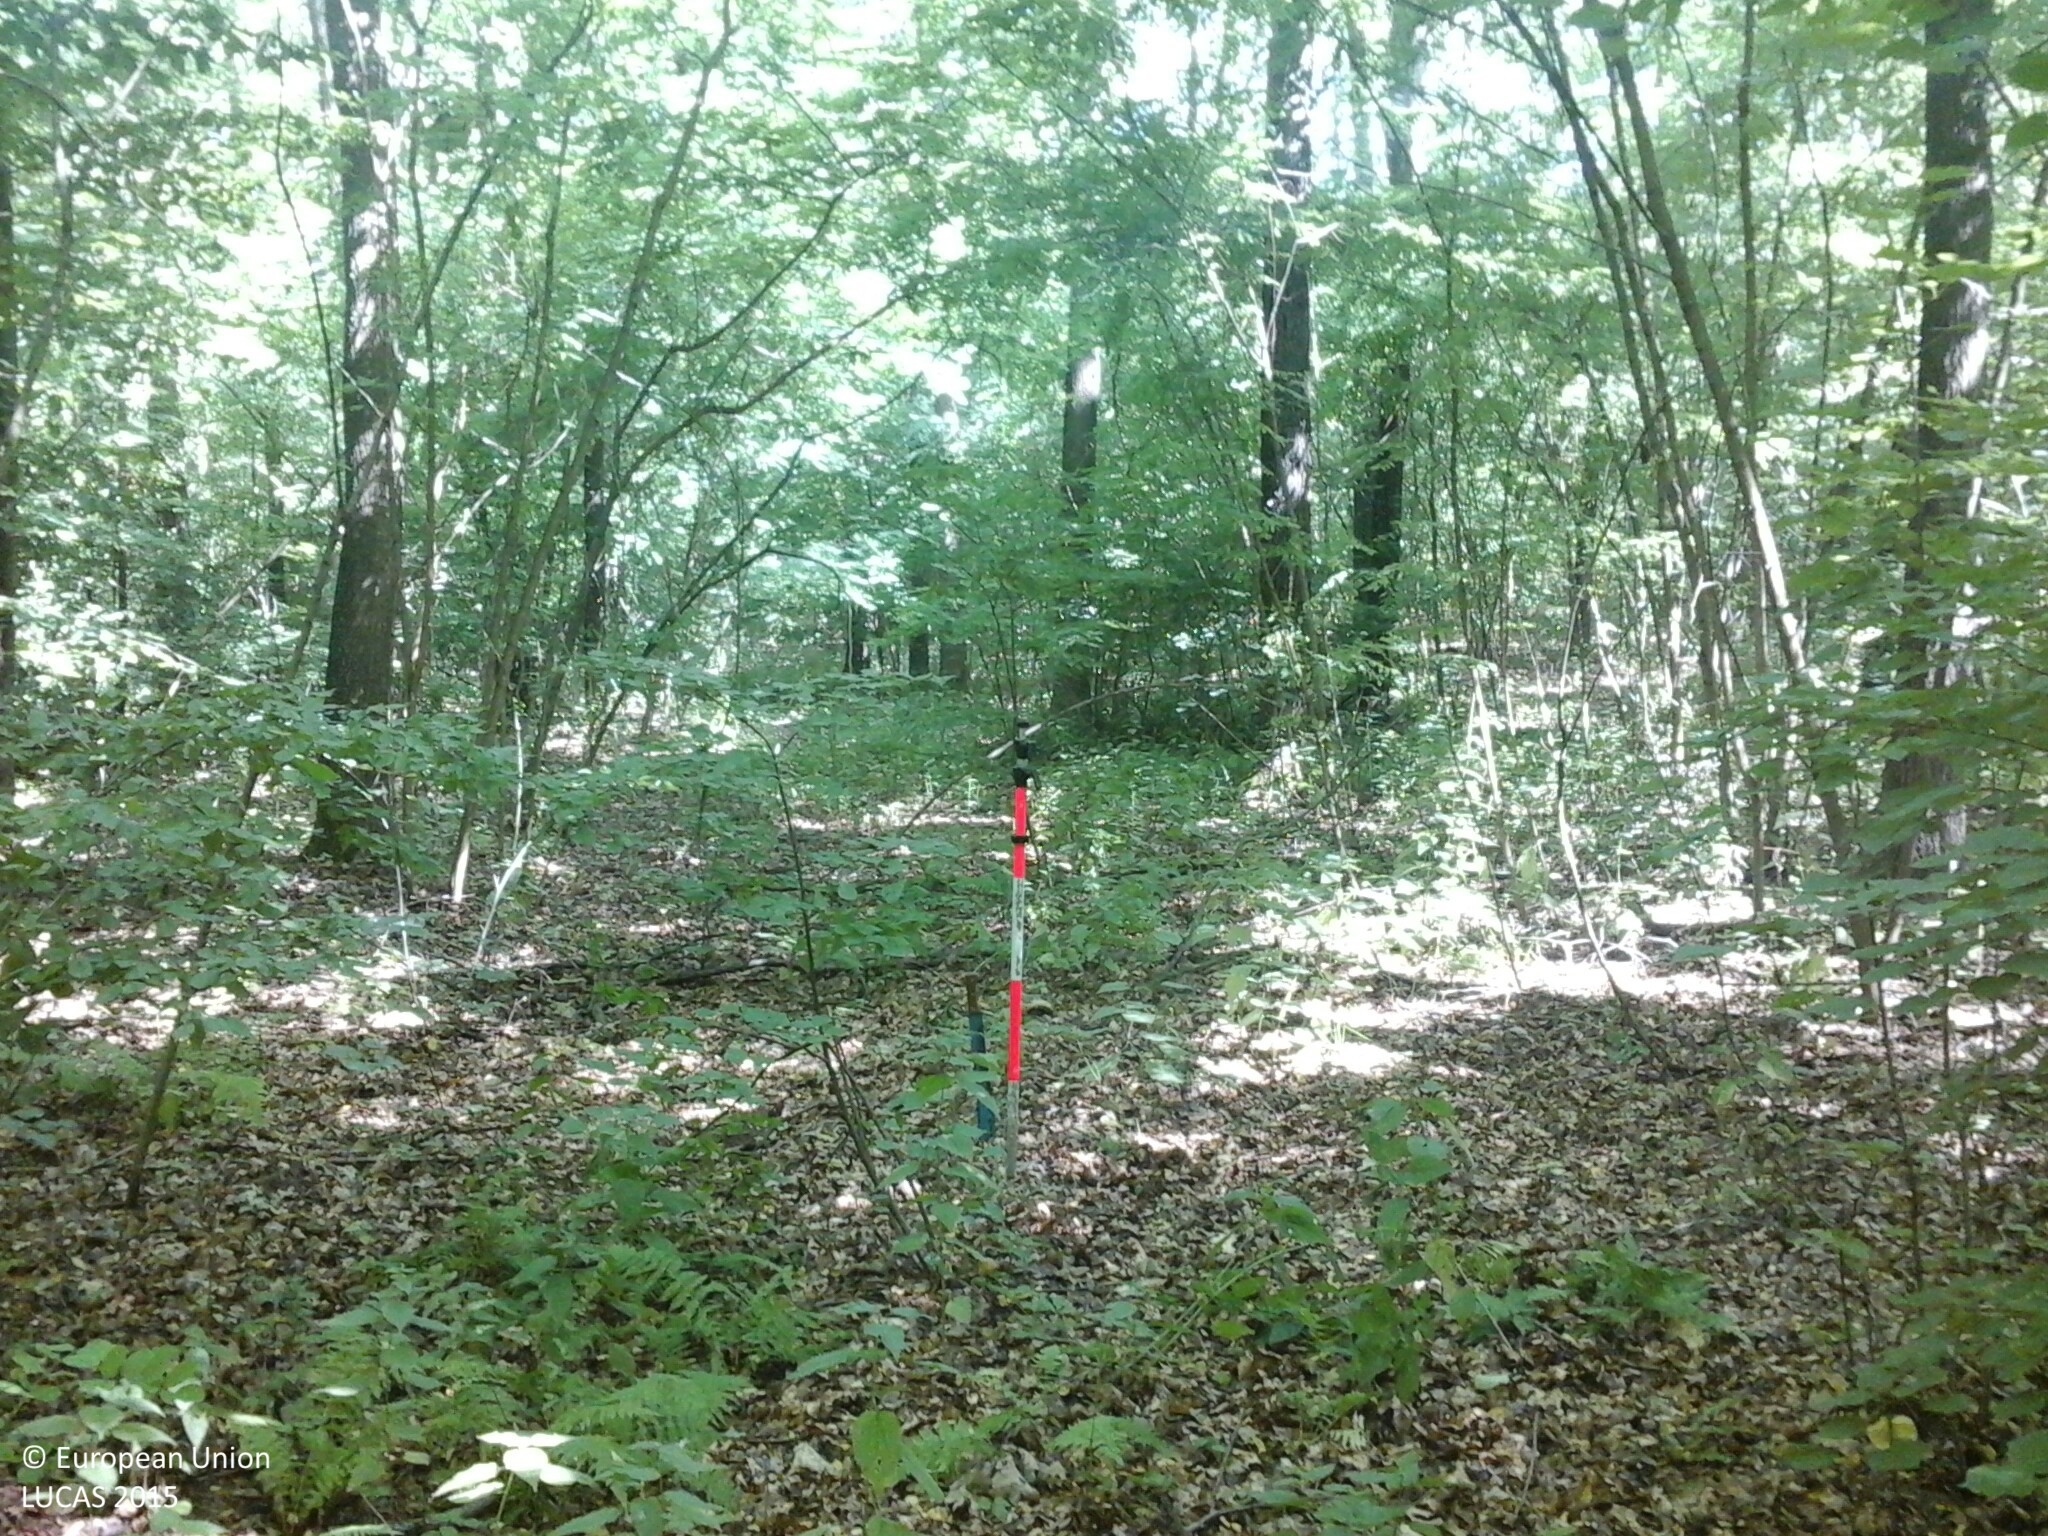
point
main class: Woodland
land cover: Broadleaved woodland
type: mesophytic deciduous forest
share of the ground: > 75 %
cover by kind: broadleaved forest trees 90 %, herbaceous plants 10 %
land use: Forestry
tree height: > 5 m
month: July
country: HU
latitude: 48.0616
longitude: 22.2808
